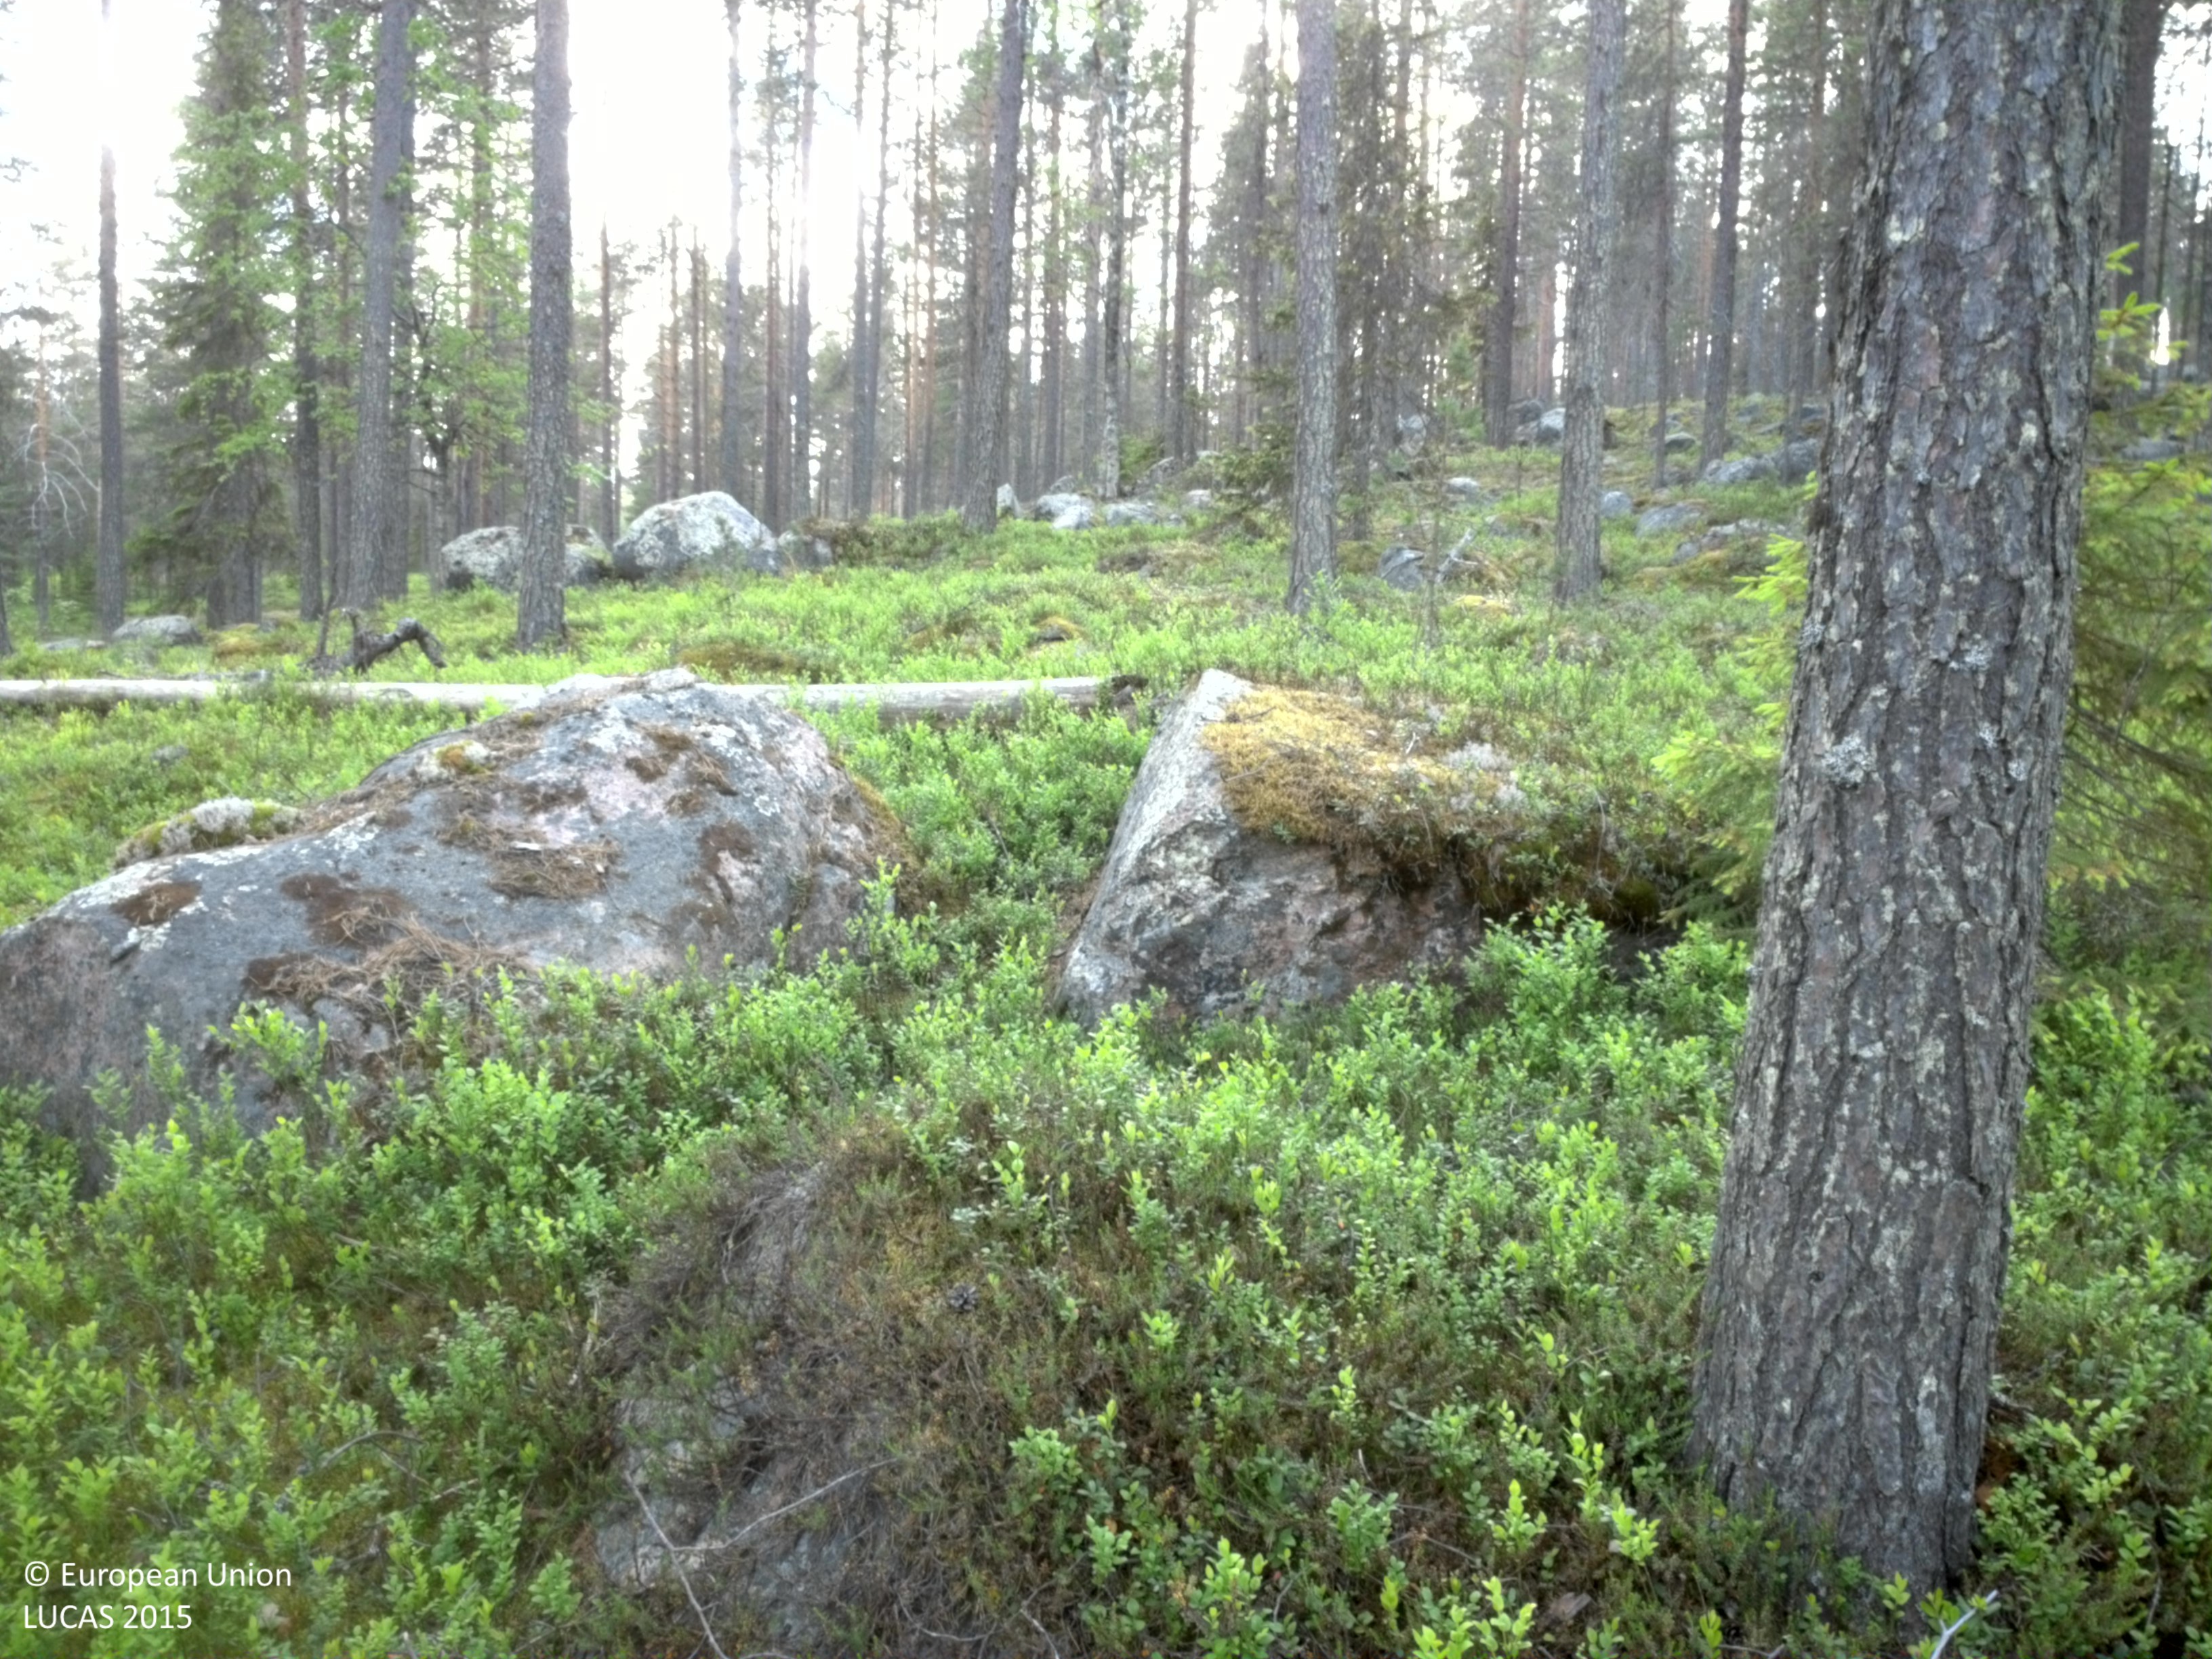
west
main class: Woodland
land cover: Pine dominated coniferous woodland
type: boreal forest
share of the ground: 25 - 50 %
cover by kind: shrubs 50 %, coniferous forest trees 40 %, consolidated bare surface 10 %
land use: Forestry
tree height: > 5 m
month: June
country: SE
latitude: 66.3019
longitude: 22.7985
